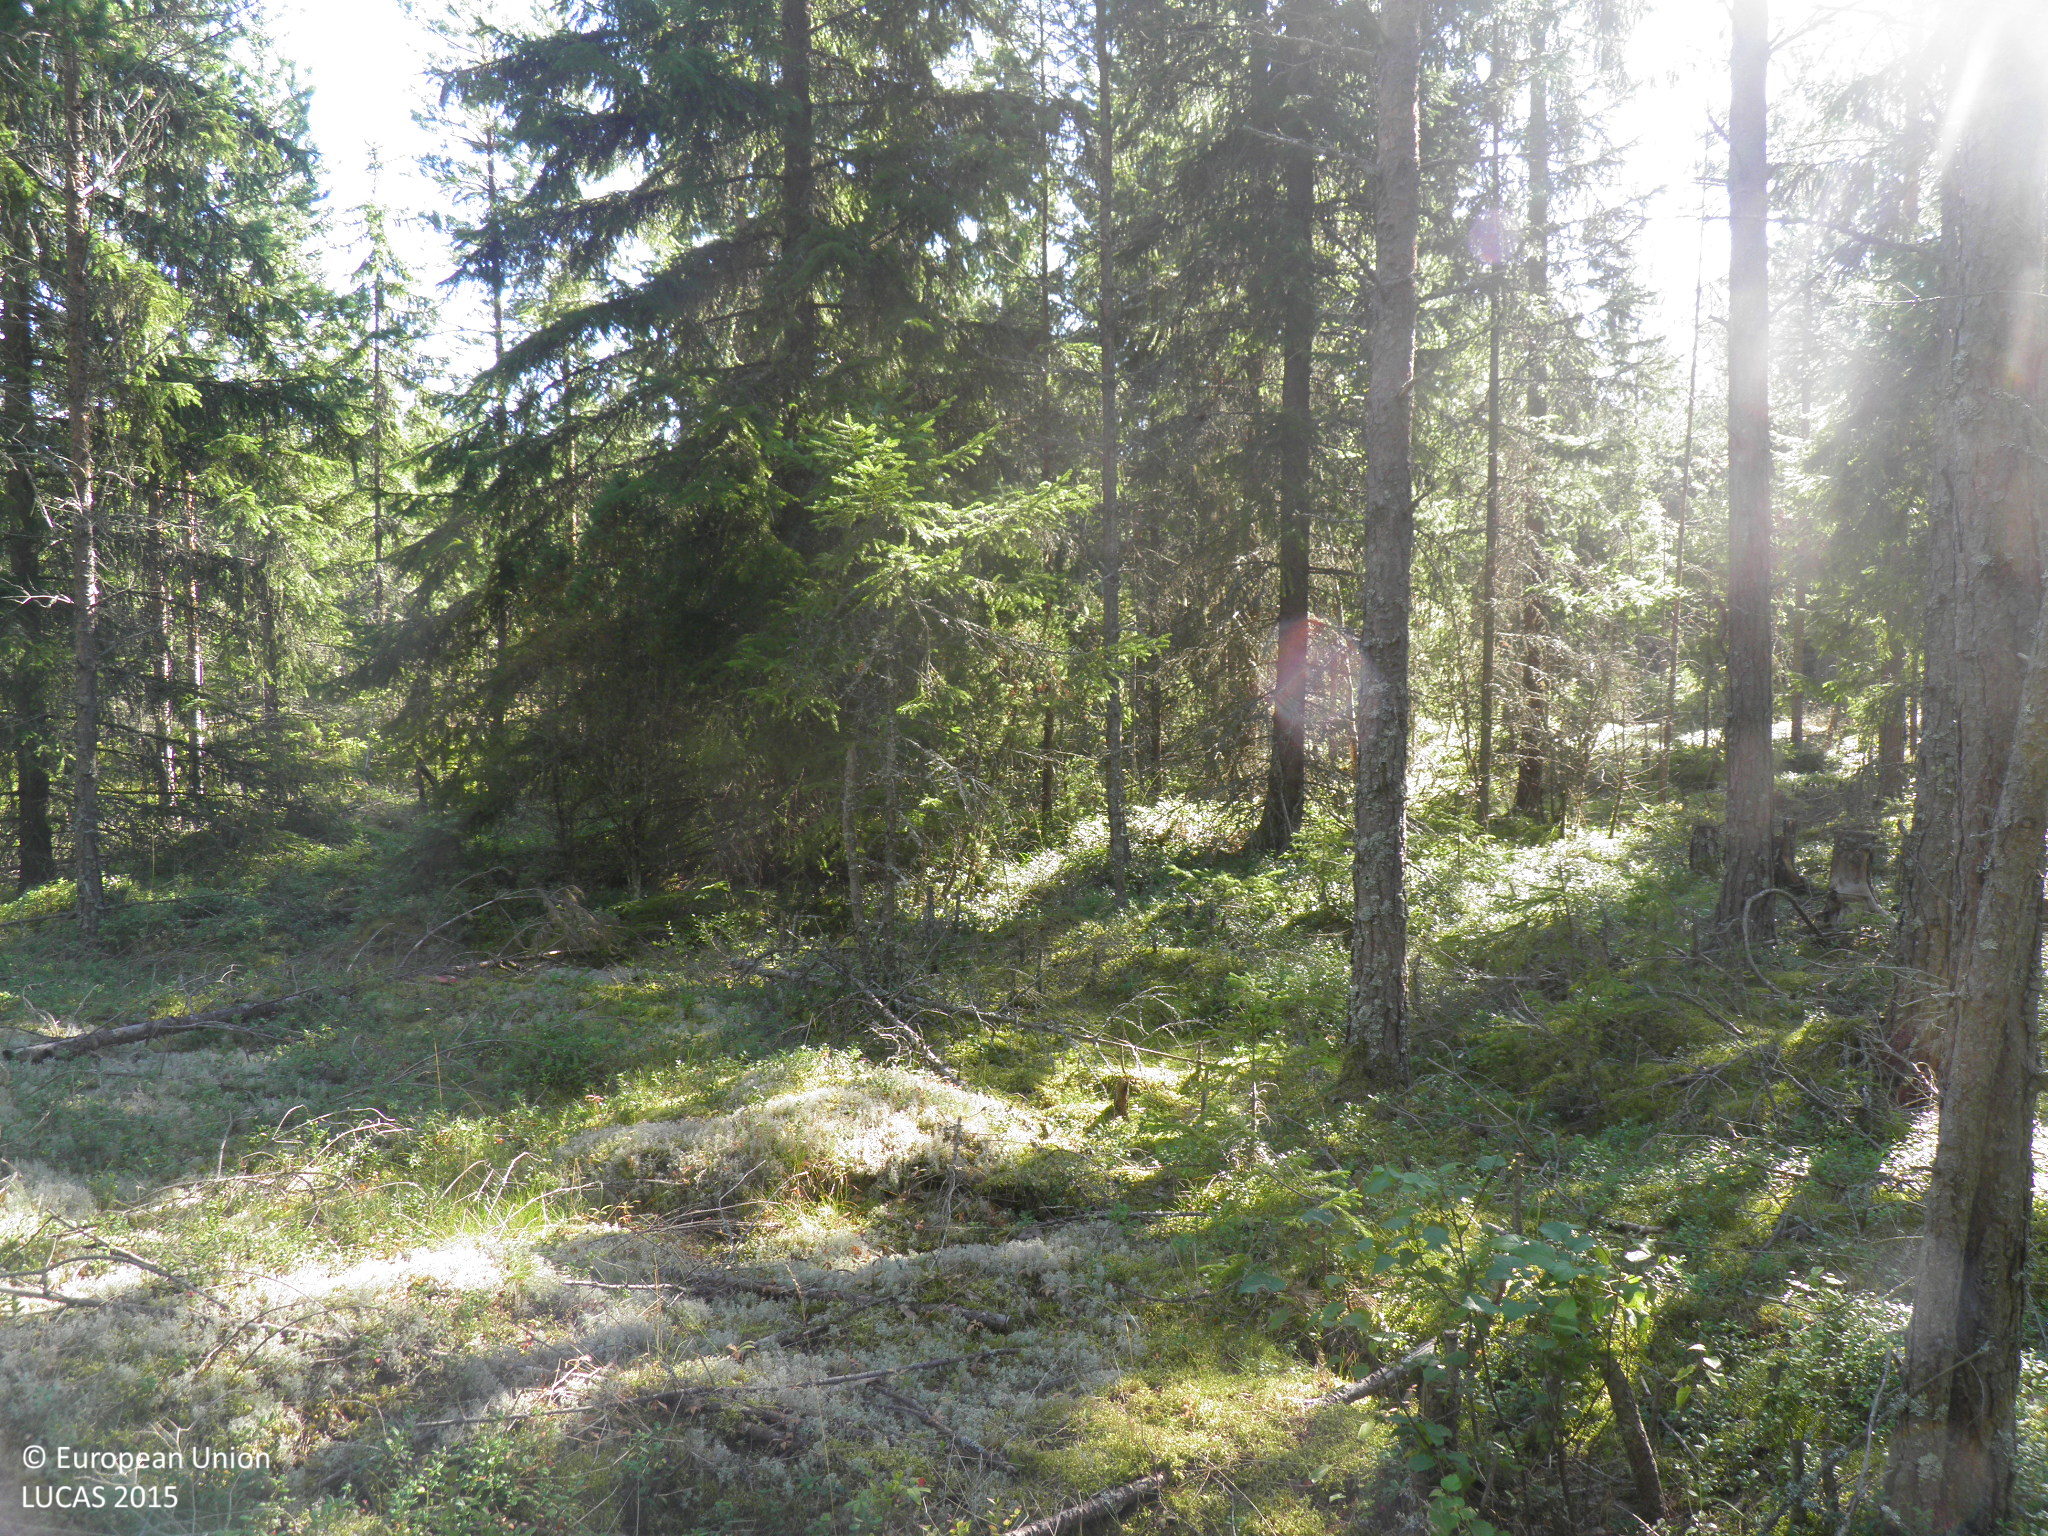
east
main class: Woodland
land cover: Pine dominated coniferous woodland
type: hemiboreal forest and nemoral coniferous forest and mixed broadleaved-coniferous forest
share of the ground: 50 - 75 %
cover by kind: coniferous forest trees 50 %, shrubs 25 %, lichens and mosses 25 %
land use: Forestry
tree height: < 5 m
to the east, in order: Pine dominated coniferous woodland; Other mixed woodland; Ditches and canals; Other mixed woodland
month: August
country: FI
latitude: 60.7367
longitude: 21.4062
